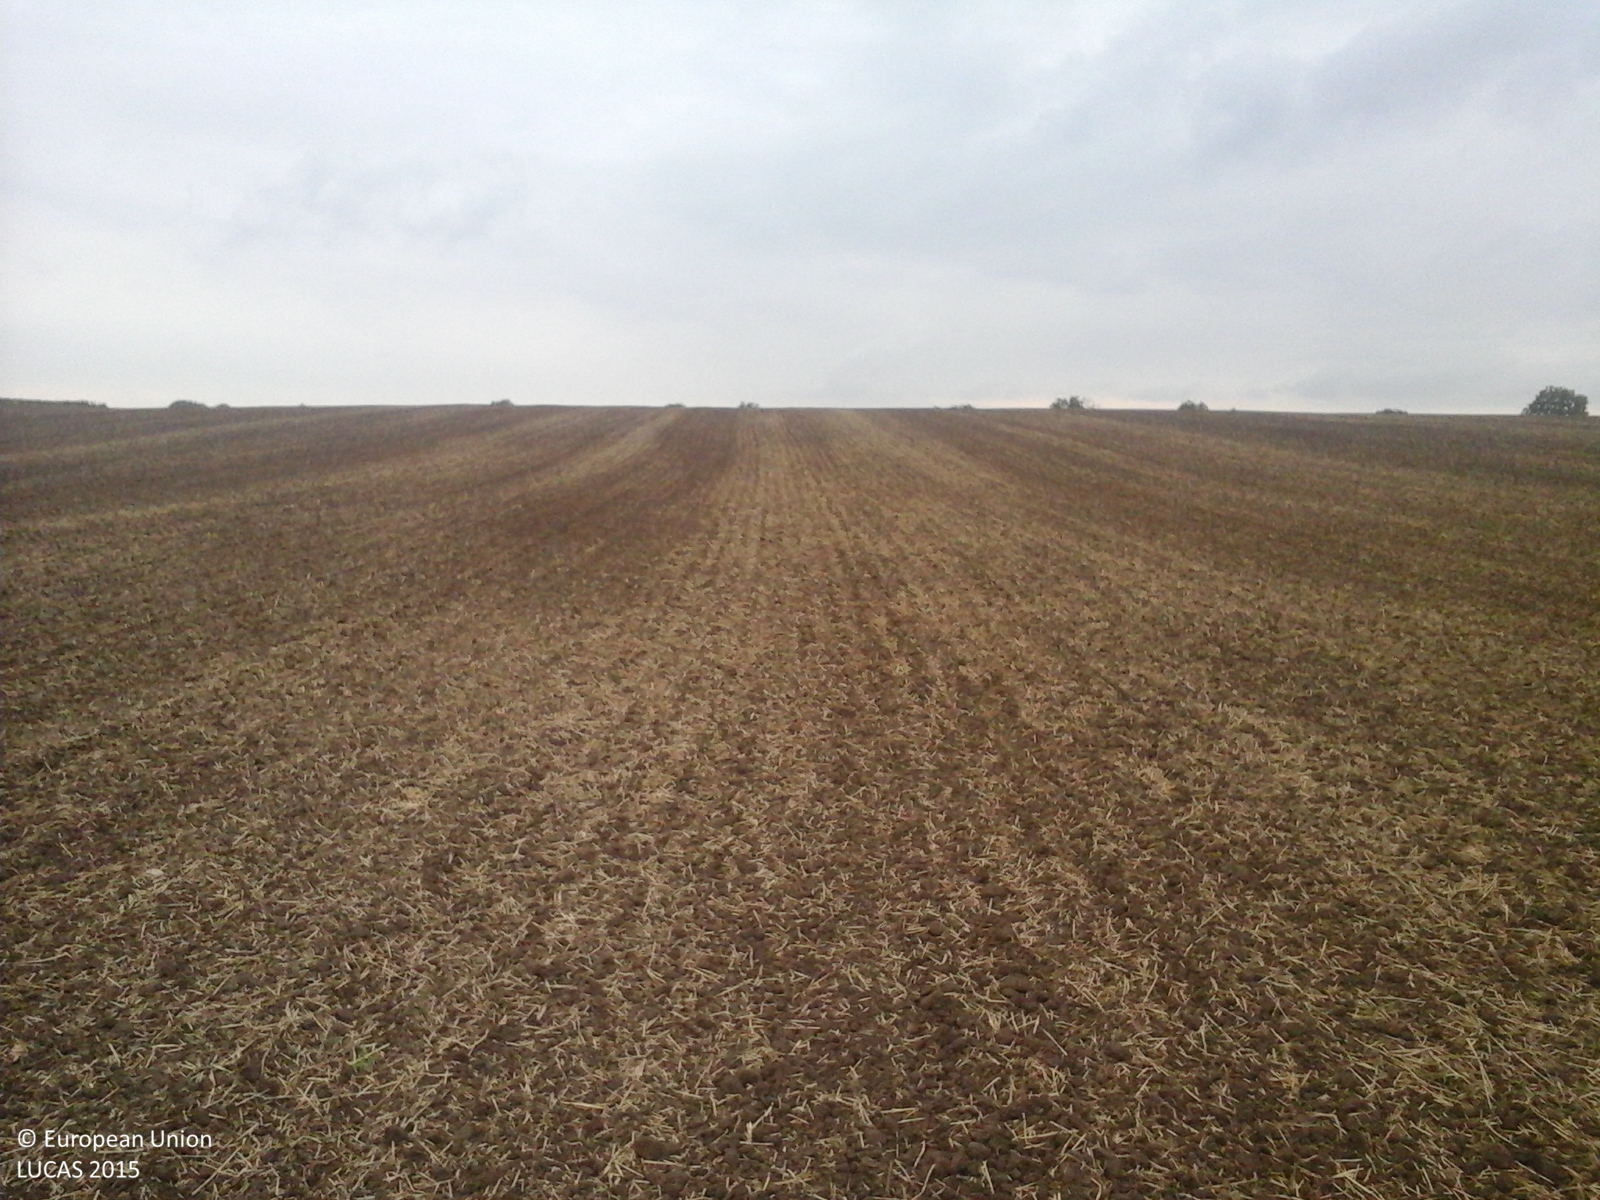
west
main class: Cropland
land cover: Common wheat
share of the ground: < 10 %
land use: Agriculture (excluding fallow land and kitchen gardens)
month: September
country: RO
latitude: 47.1843
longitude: 21.9907
